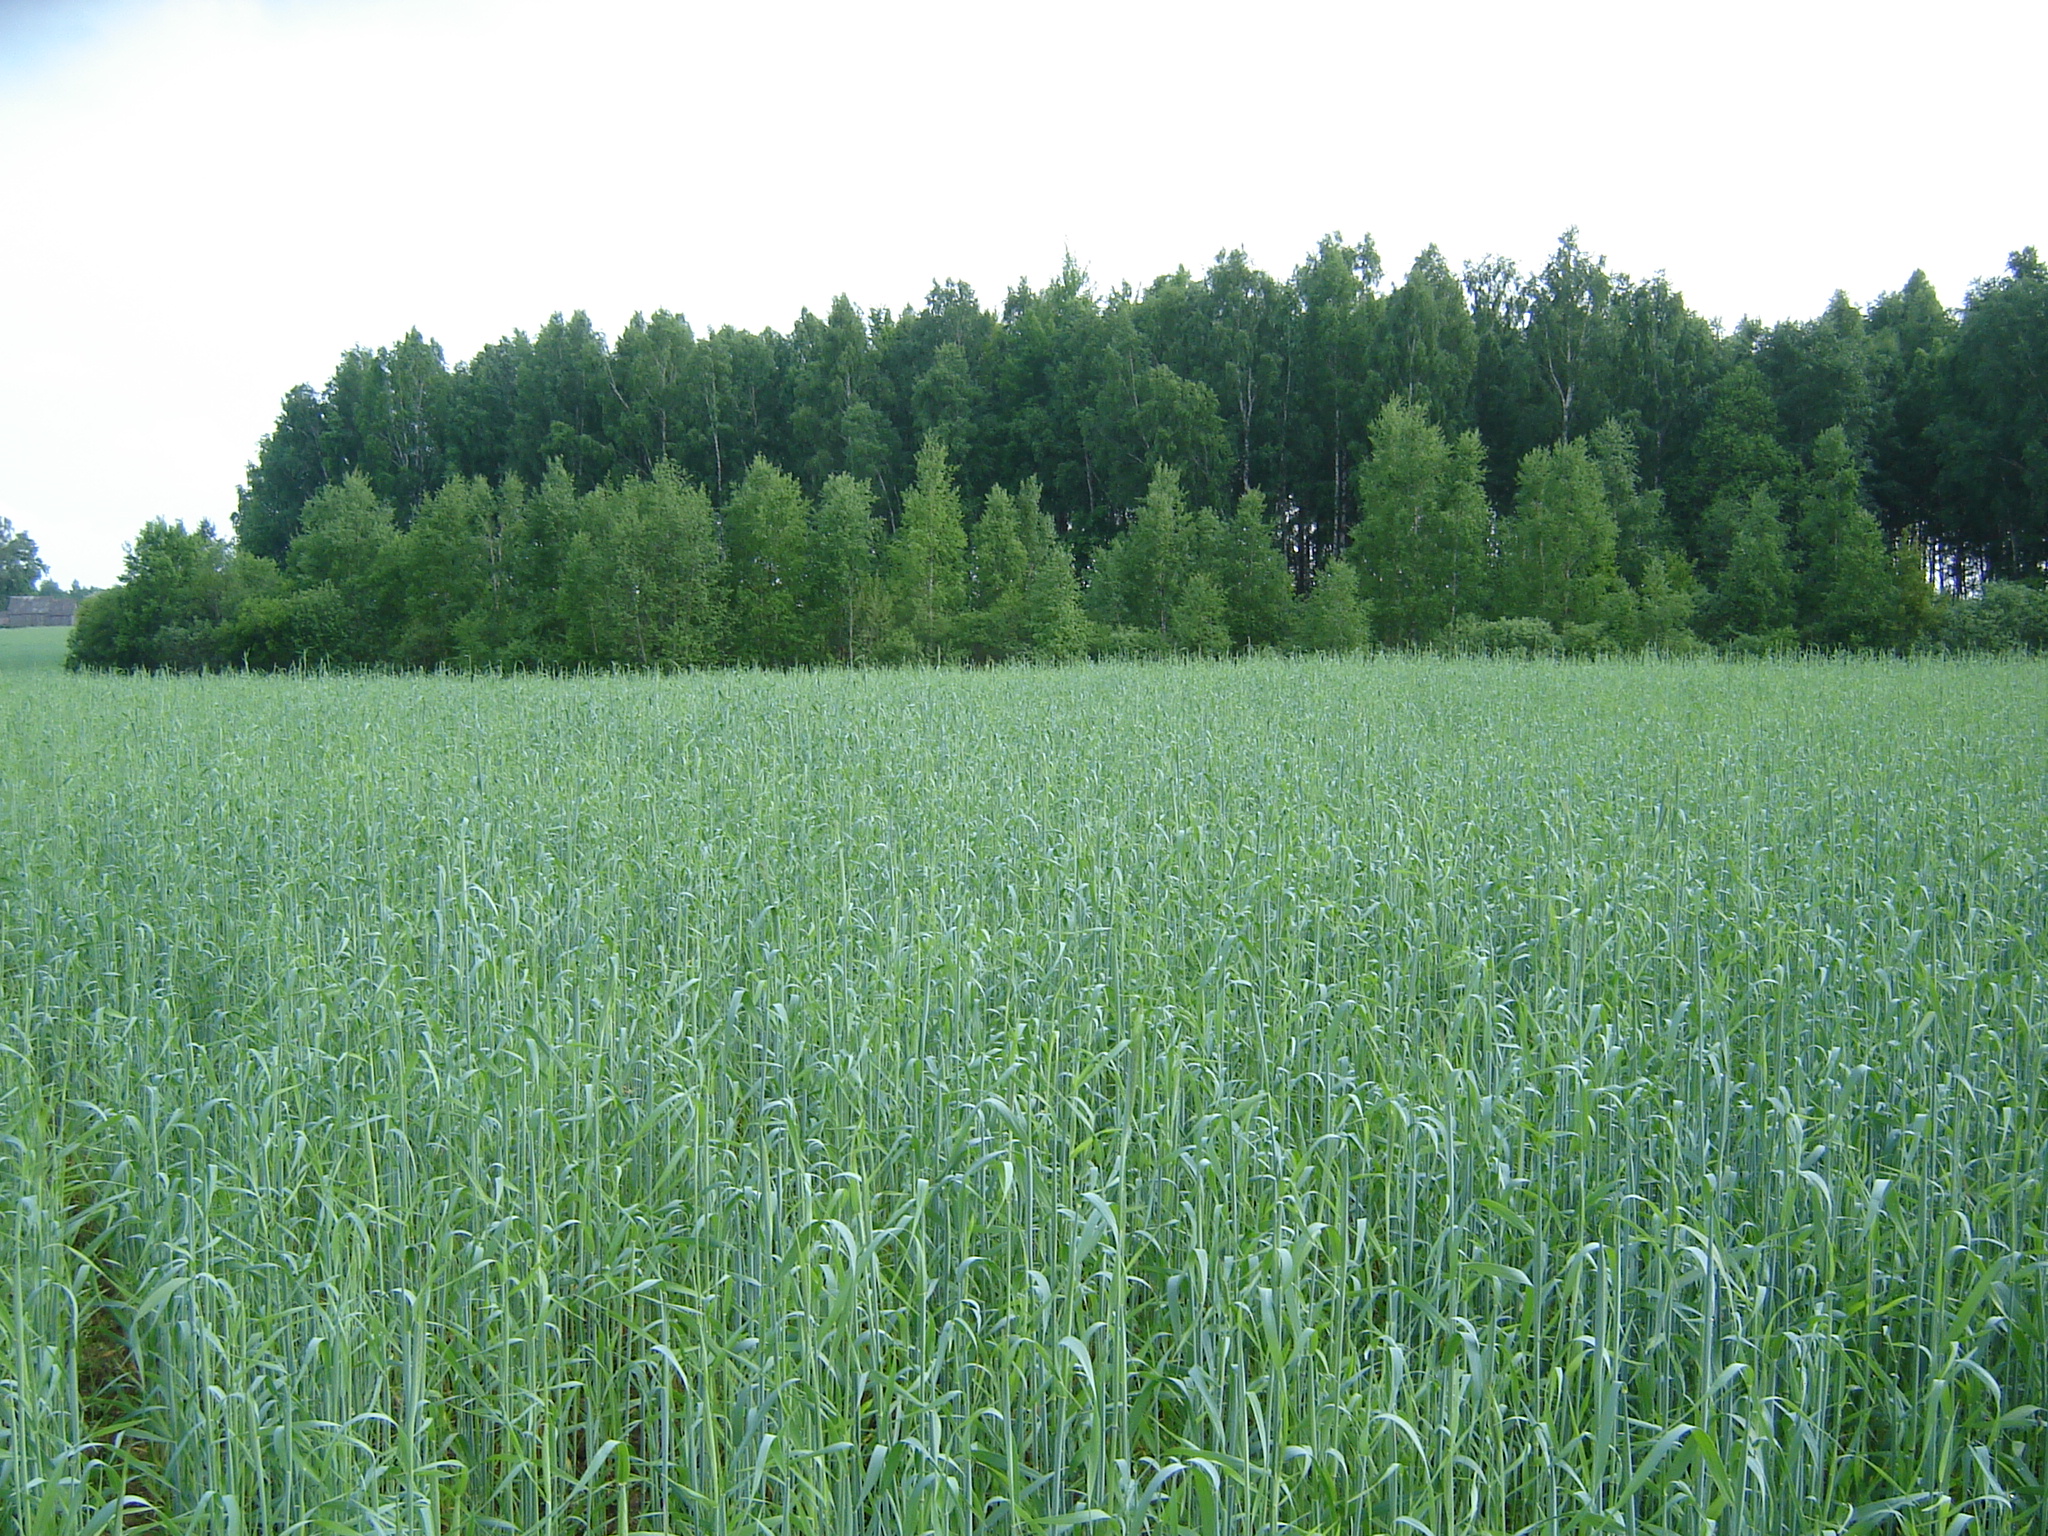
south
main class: Cropland
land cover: Rye
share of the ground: > 75 %
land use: Agriculture (excluding fallow land and kitchen gardens)
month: May
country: LT
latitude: 55.9630
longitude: 25.4190
